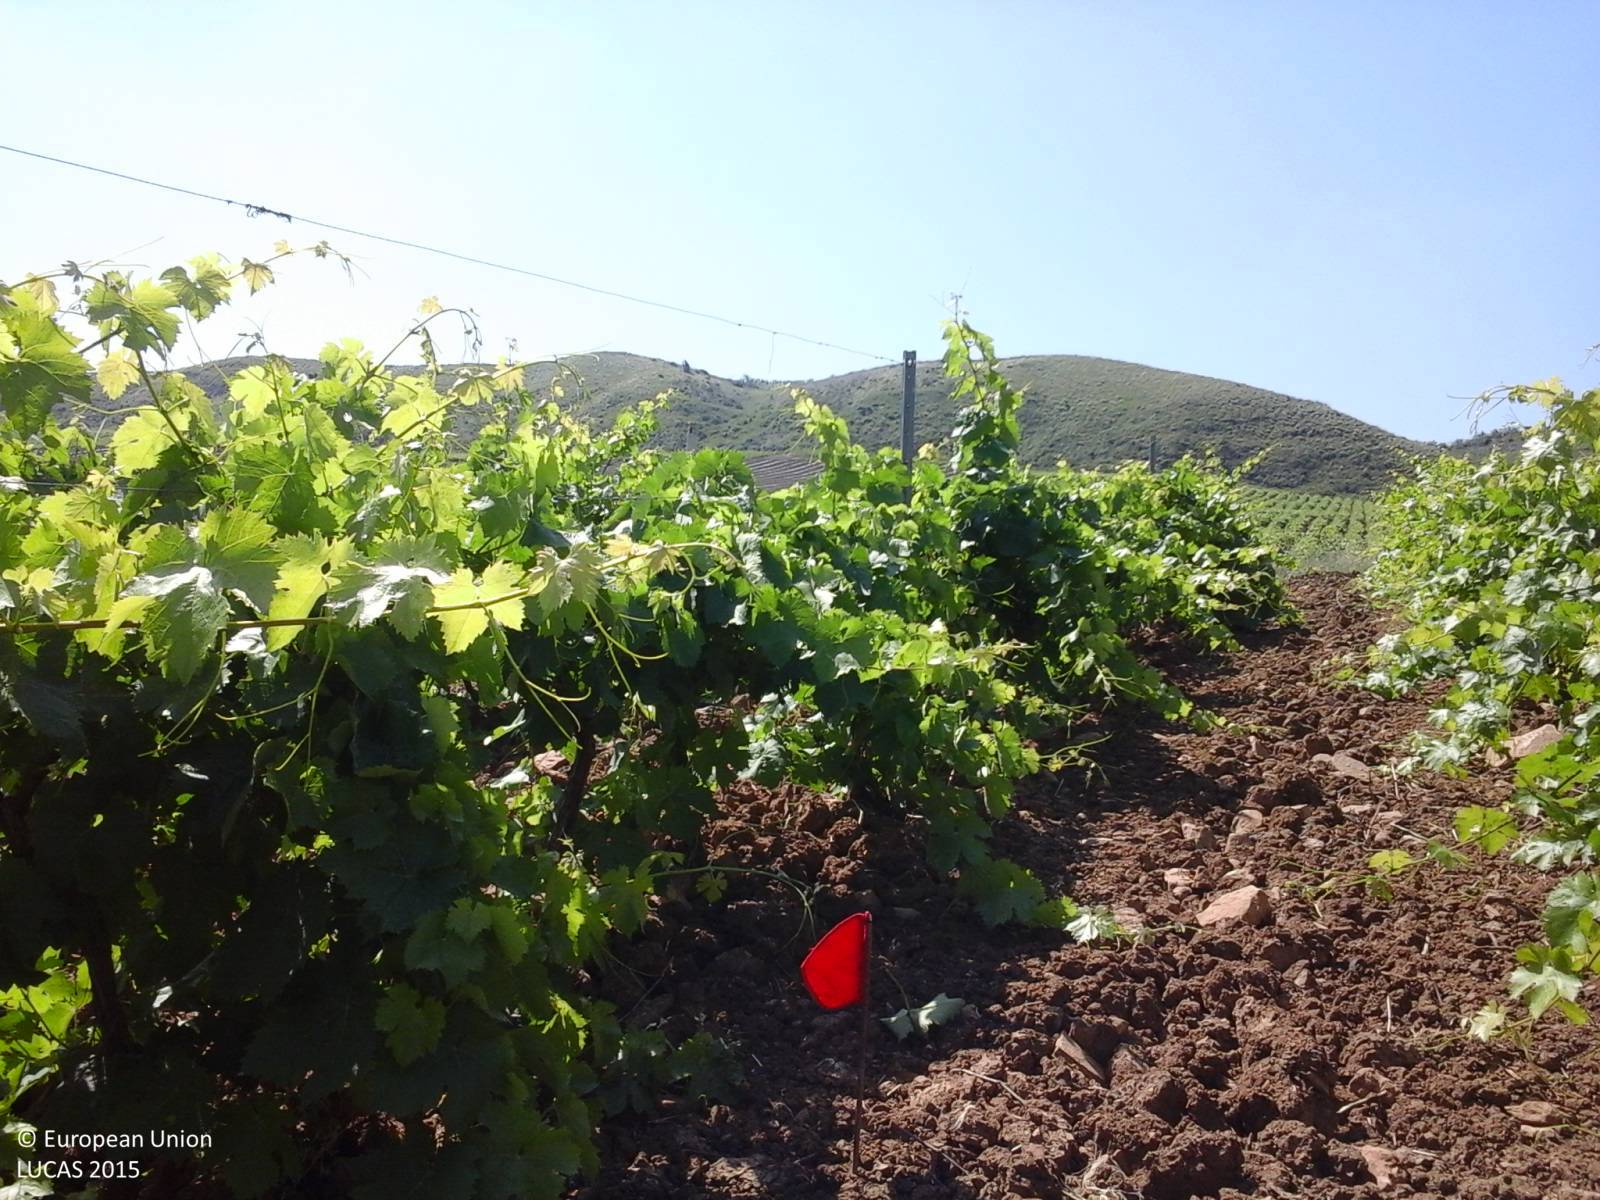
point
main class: Cropland
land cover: Vineyards
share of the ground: 50 - 75 %
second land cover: Other bare soil
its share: > 75 %
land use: Agriculture (excluding fallow land and kitchen gardens)
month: June
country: IT
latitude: 37.9344
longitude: 13.0612
